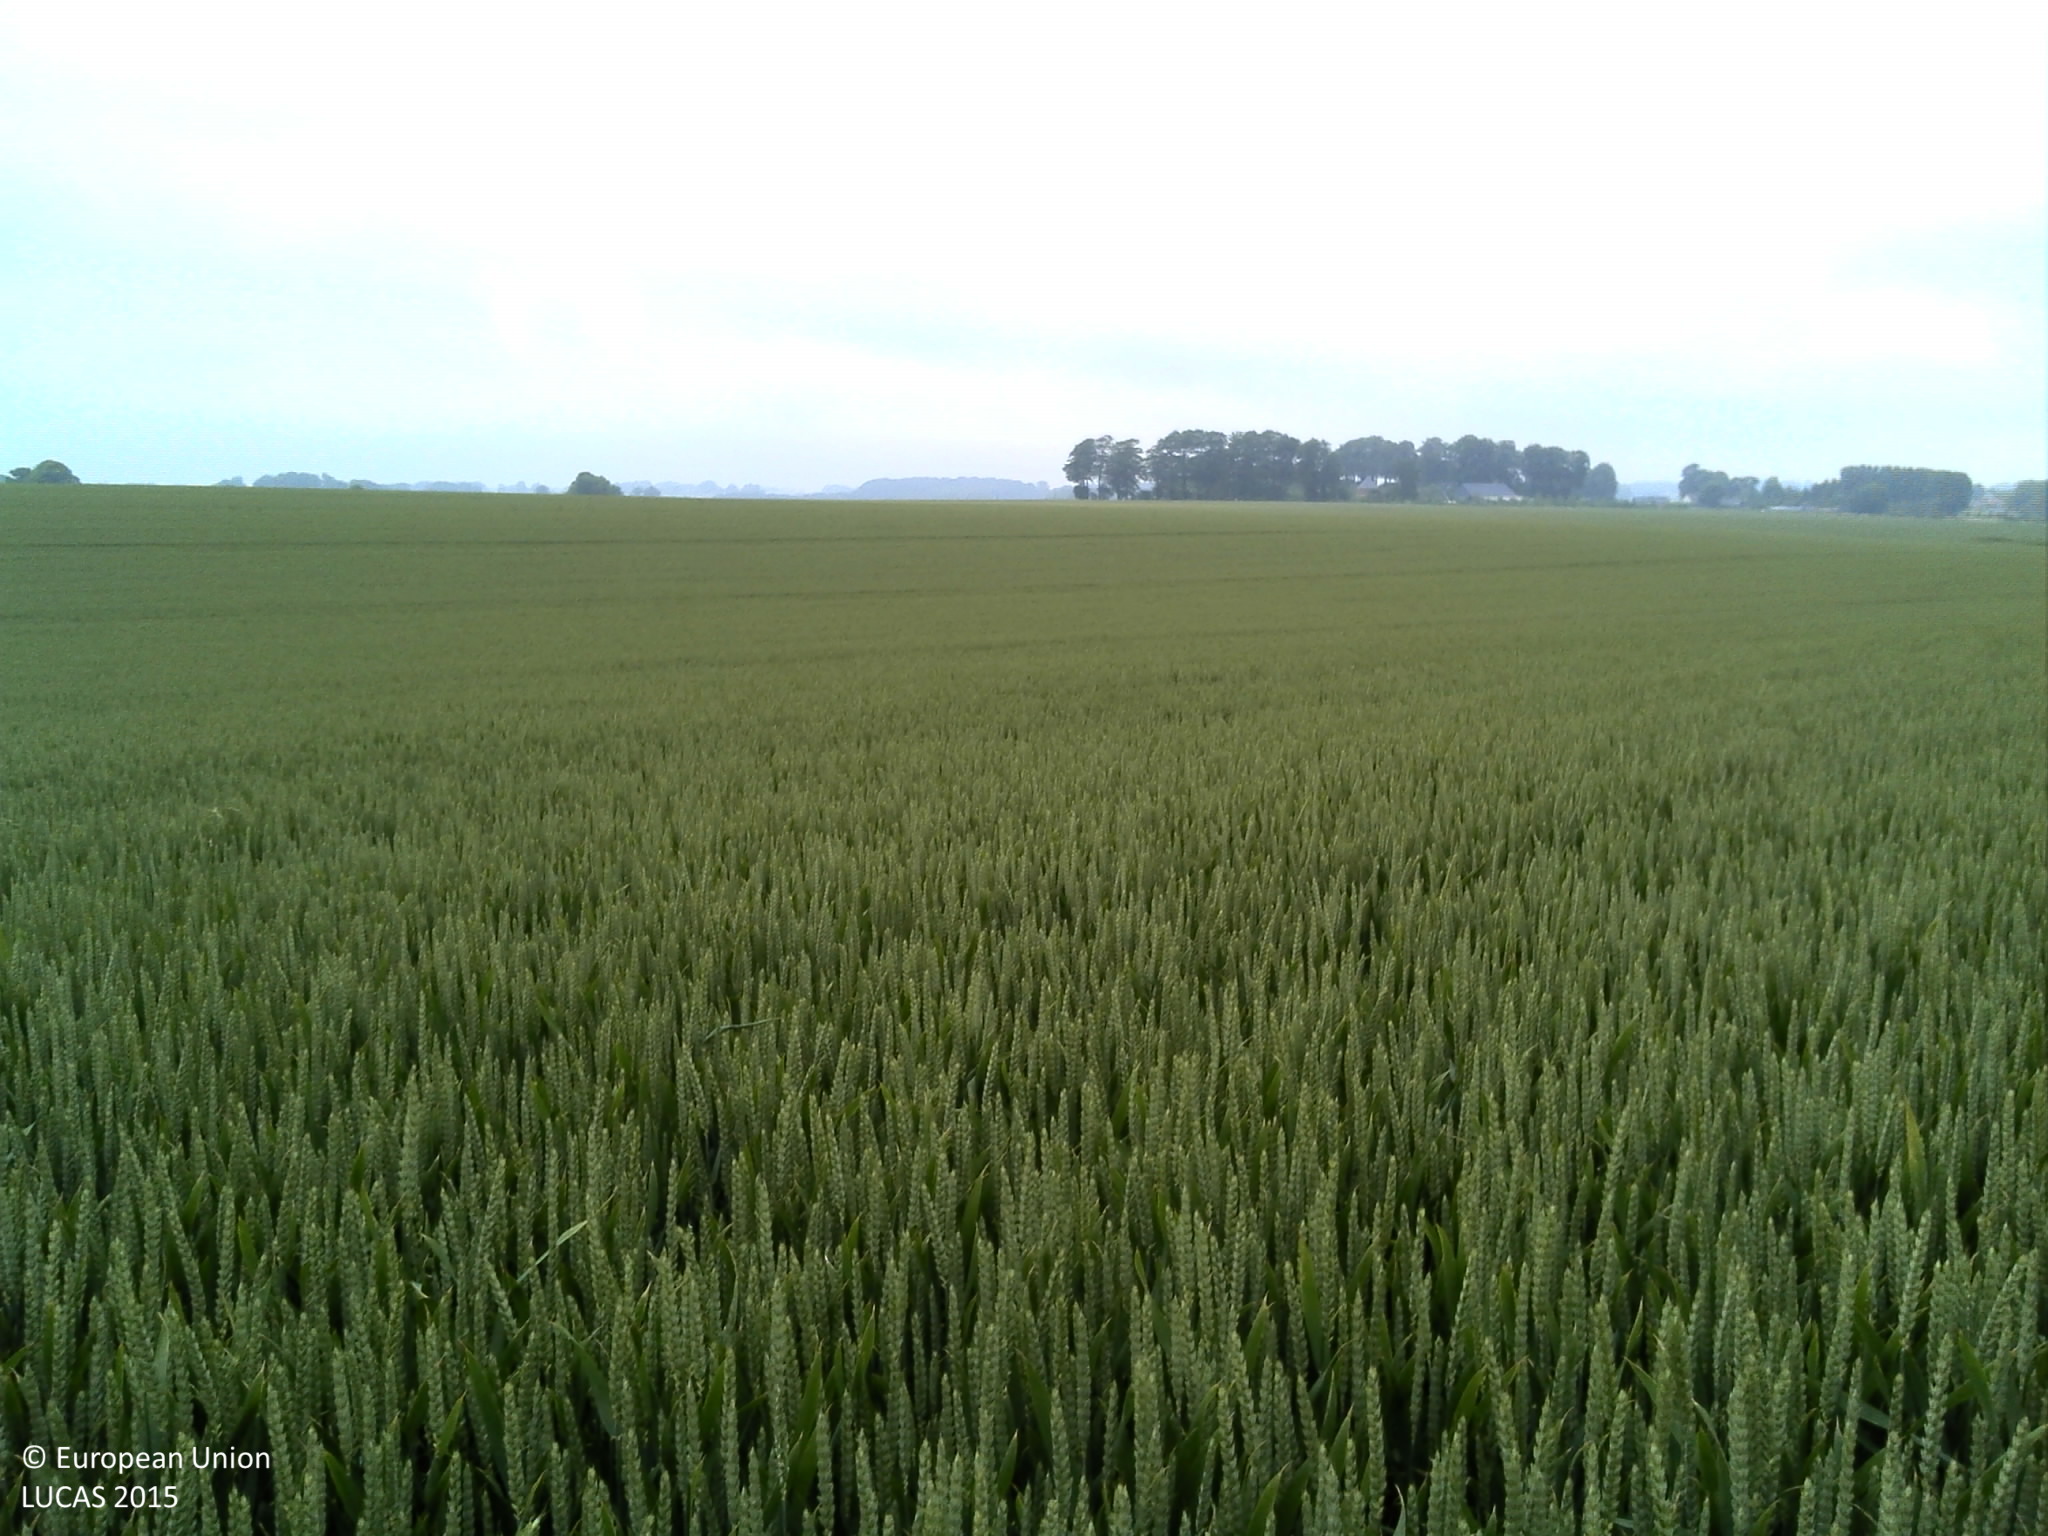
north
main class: Cropland
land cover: Common wheat
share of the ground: > 75 %
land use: Agriculture (excluding fallow land and kitchen gardens)
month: June
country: FR
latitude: 49.6493
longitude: 0.3737
